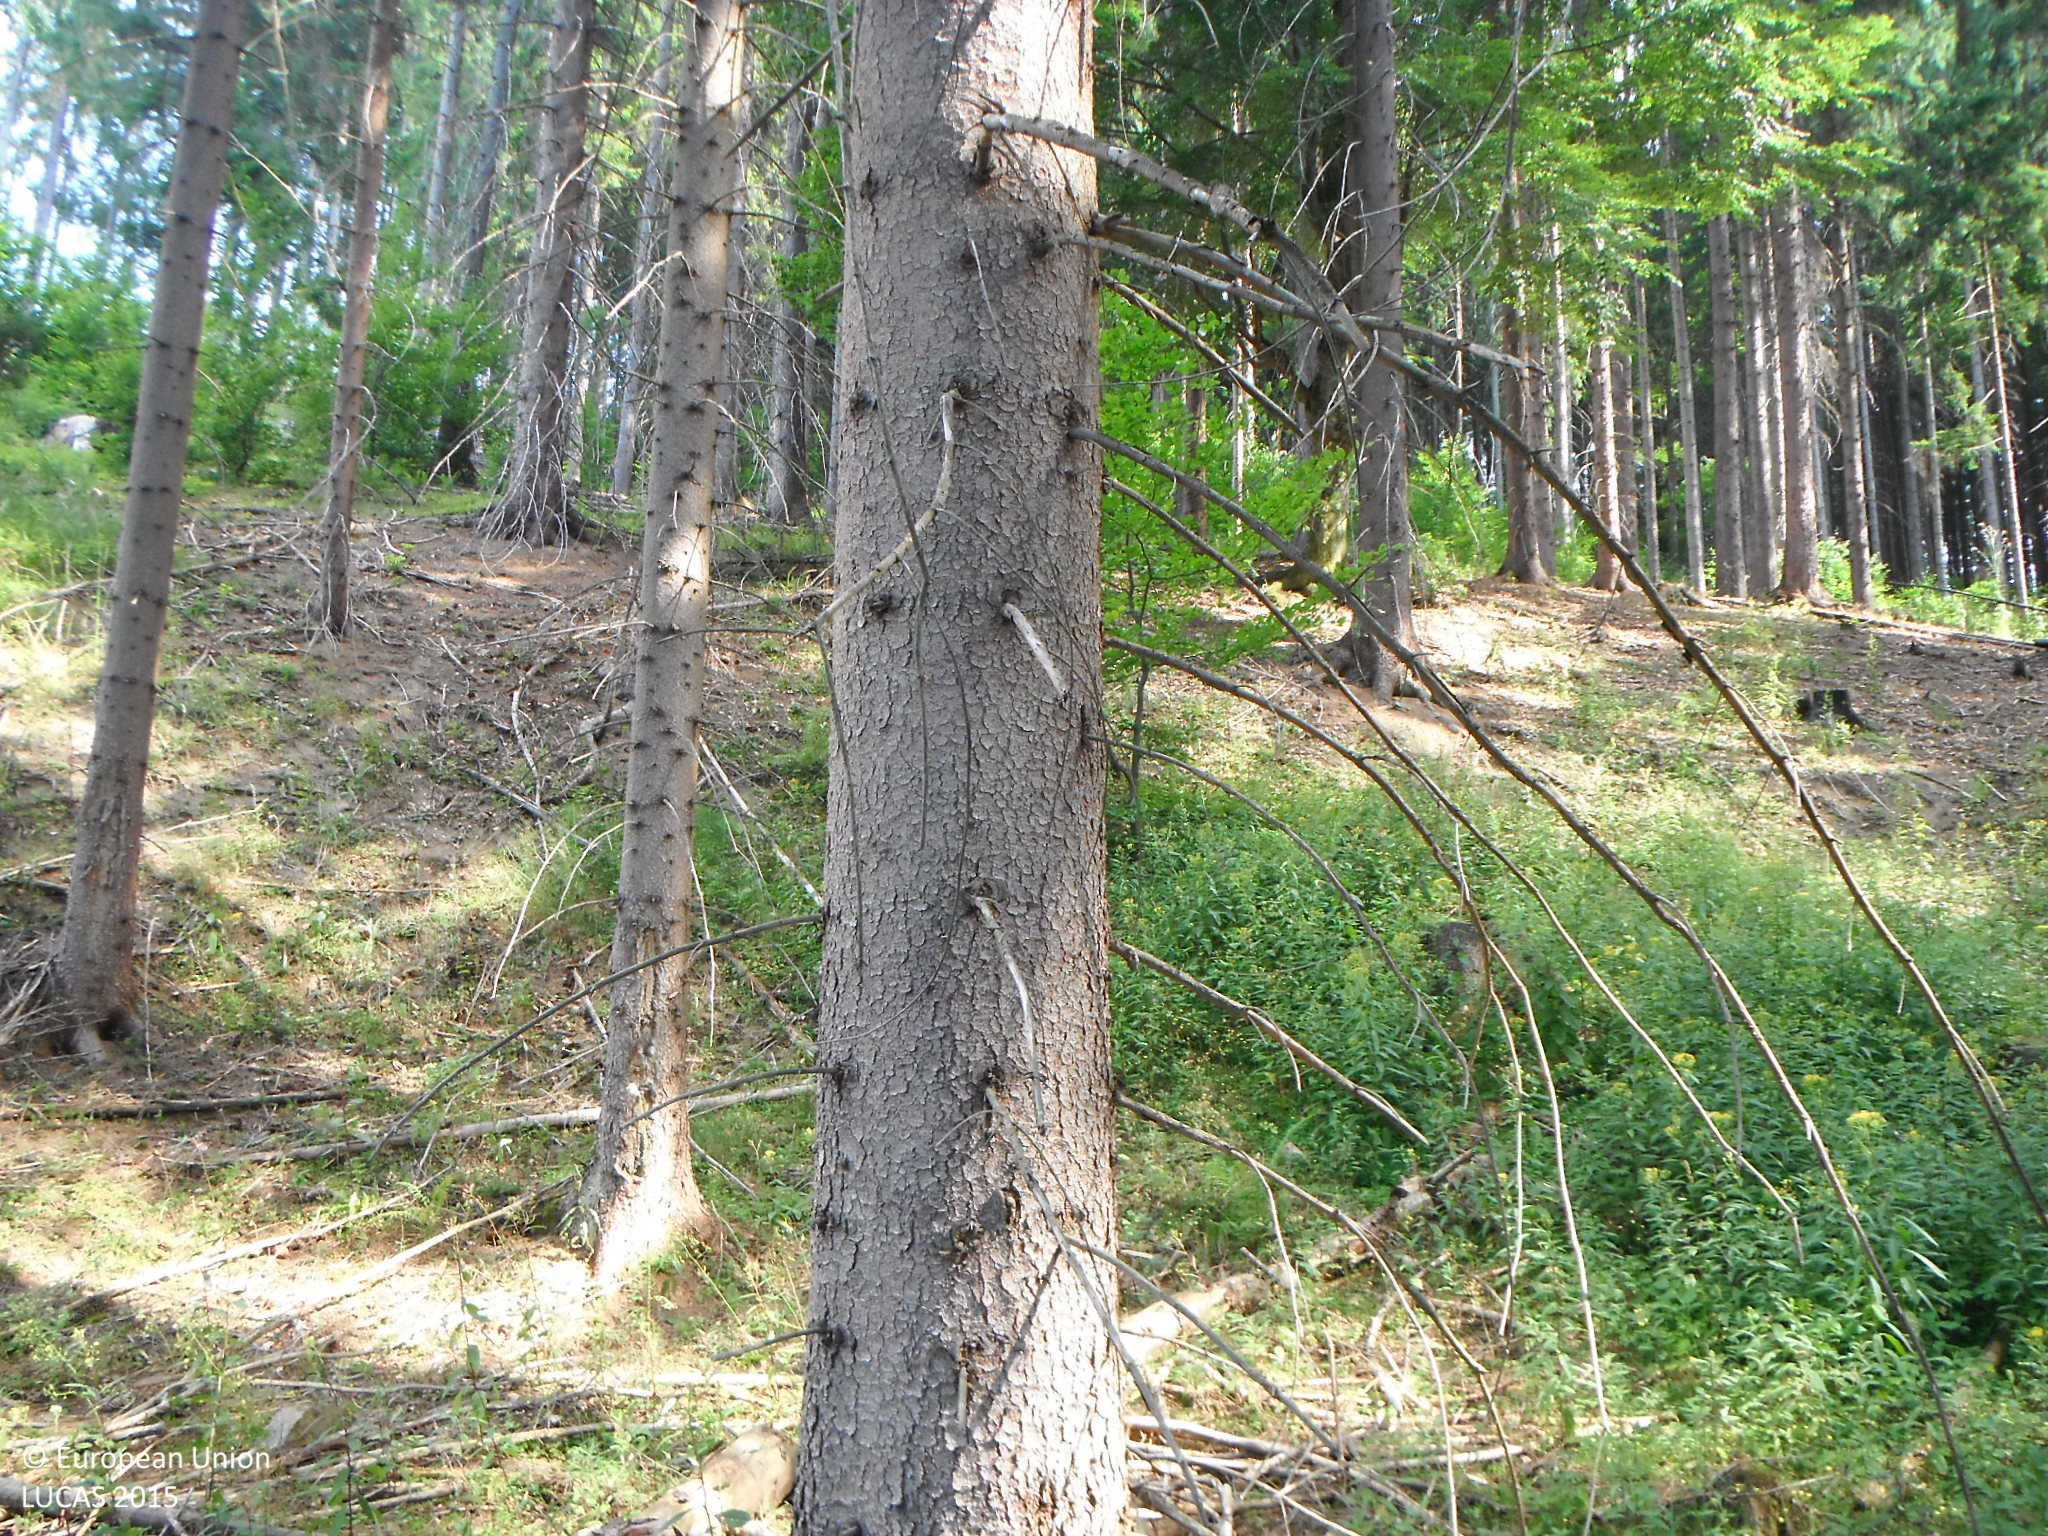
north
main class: Woodland
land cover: Spruce dominated coniferous woodland
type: alpine coniferous forest
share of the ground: > 75 %
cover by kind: coniferous forest trees 100 %
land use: Forestry
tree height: > 5 m
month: July
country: SK
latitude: 49.3496
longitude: 19.0945
